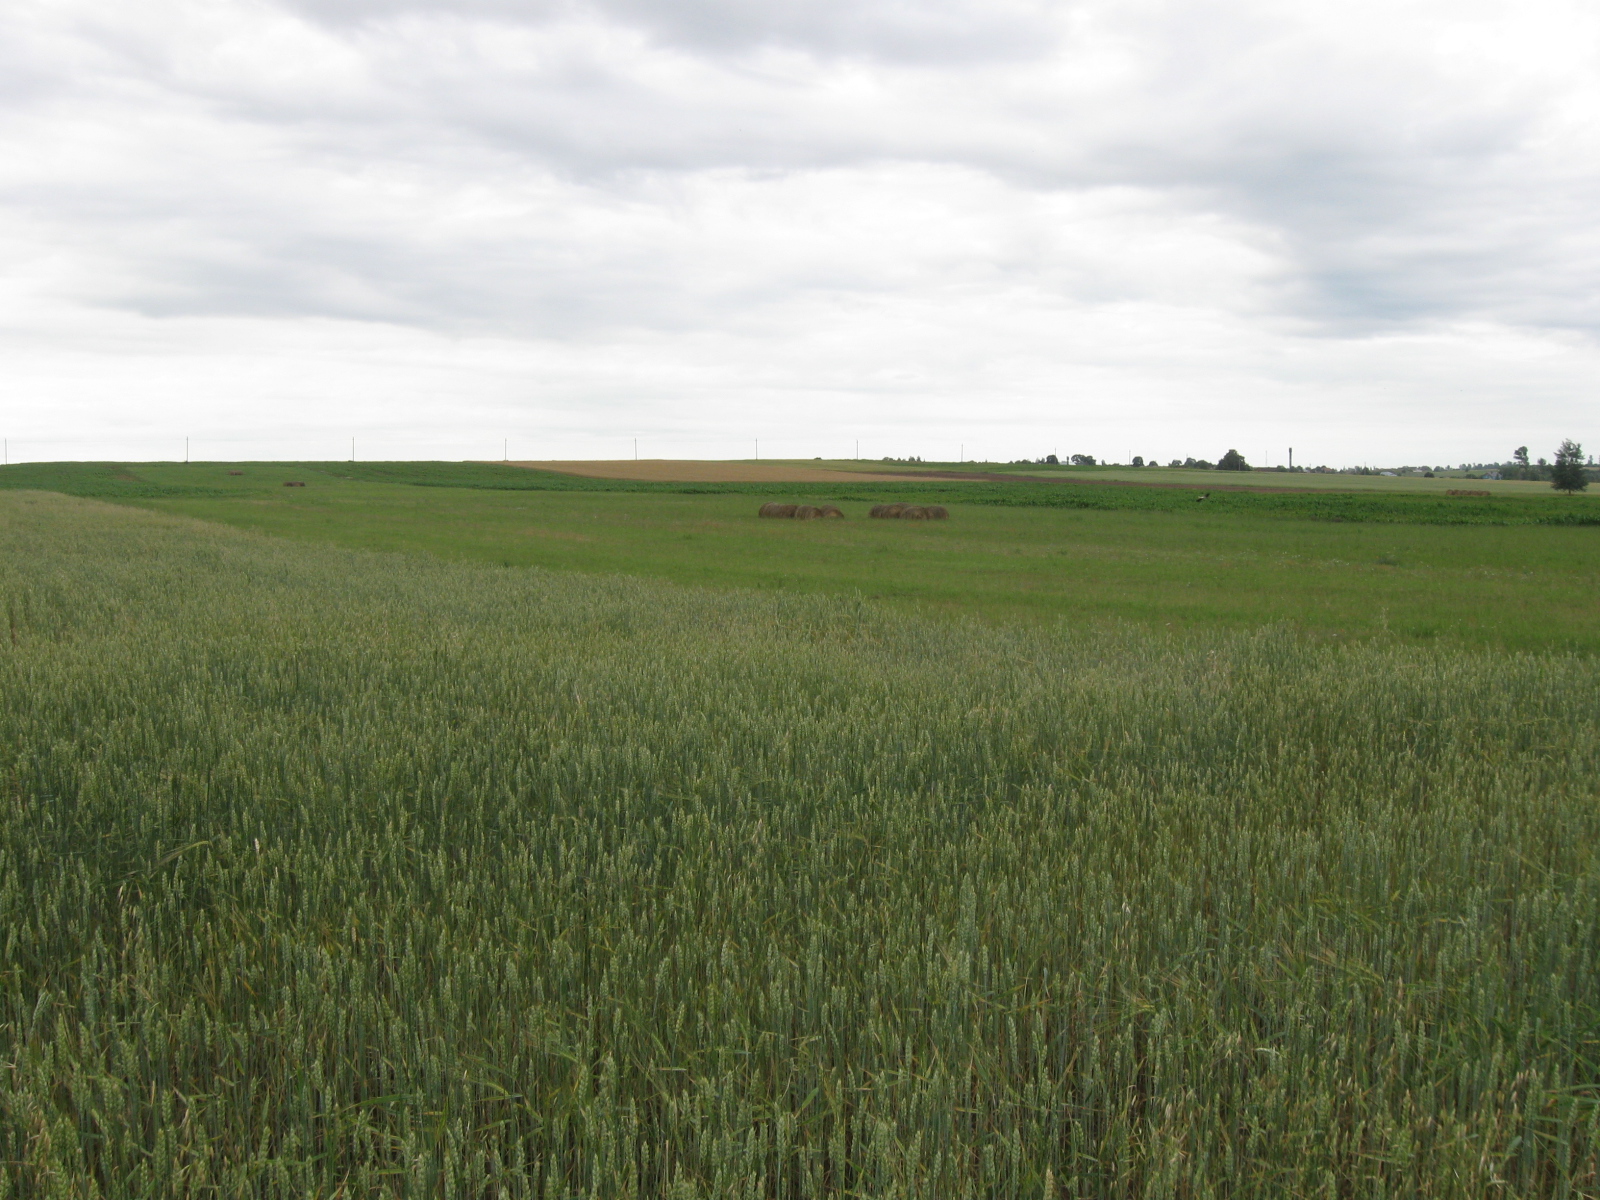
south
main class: Grassland
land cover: Grassland without tree/shrub cover
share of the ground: > 75 %
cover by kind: herbaceous plants 90 %, unconsolidated bare surface 10 %
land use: Agriculture (excluding fallow land and kitchen gardens)
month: July
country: LT
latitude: 55.0128
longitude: 23.6734
